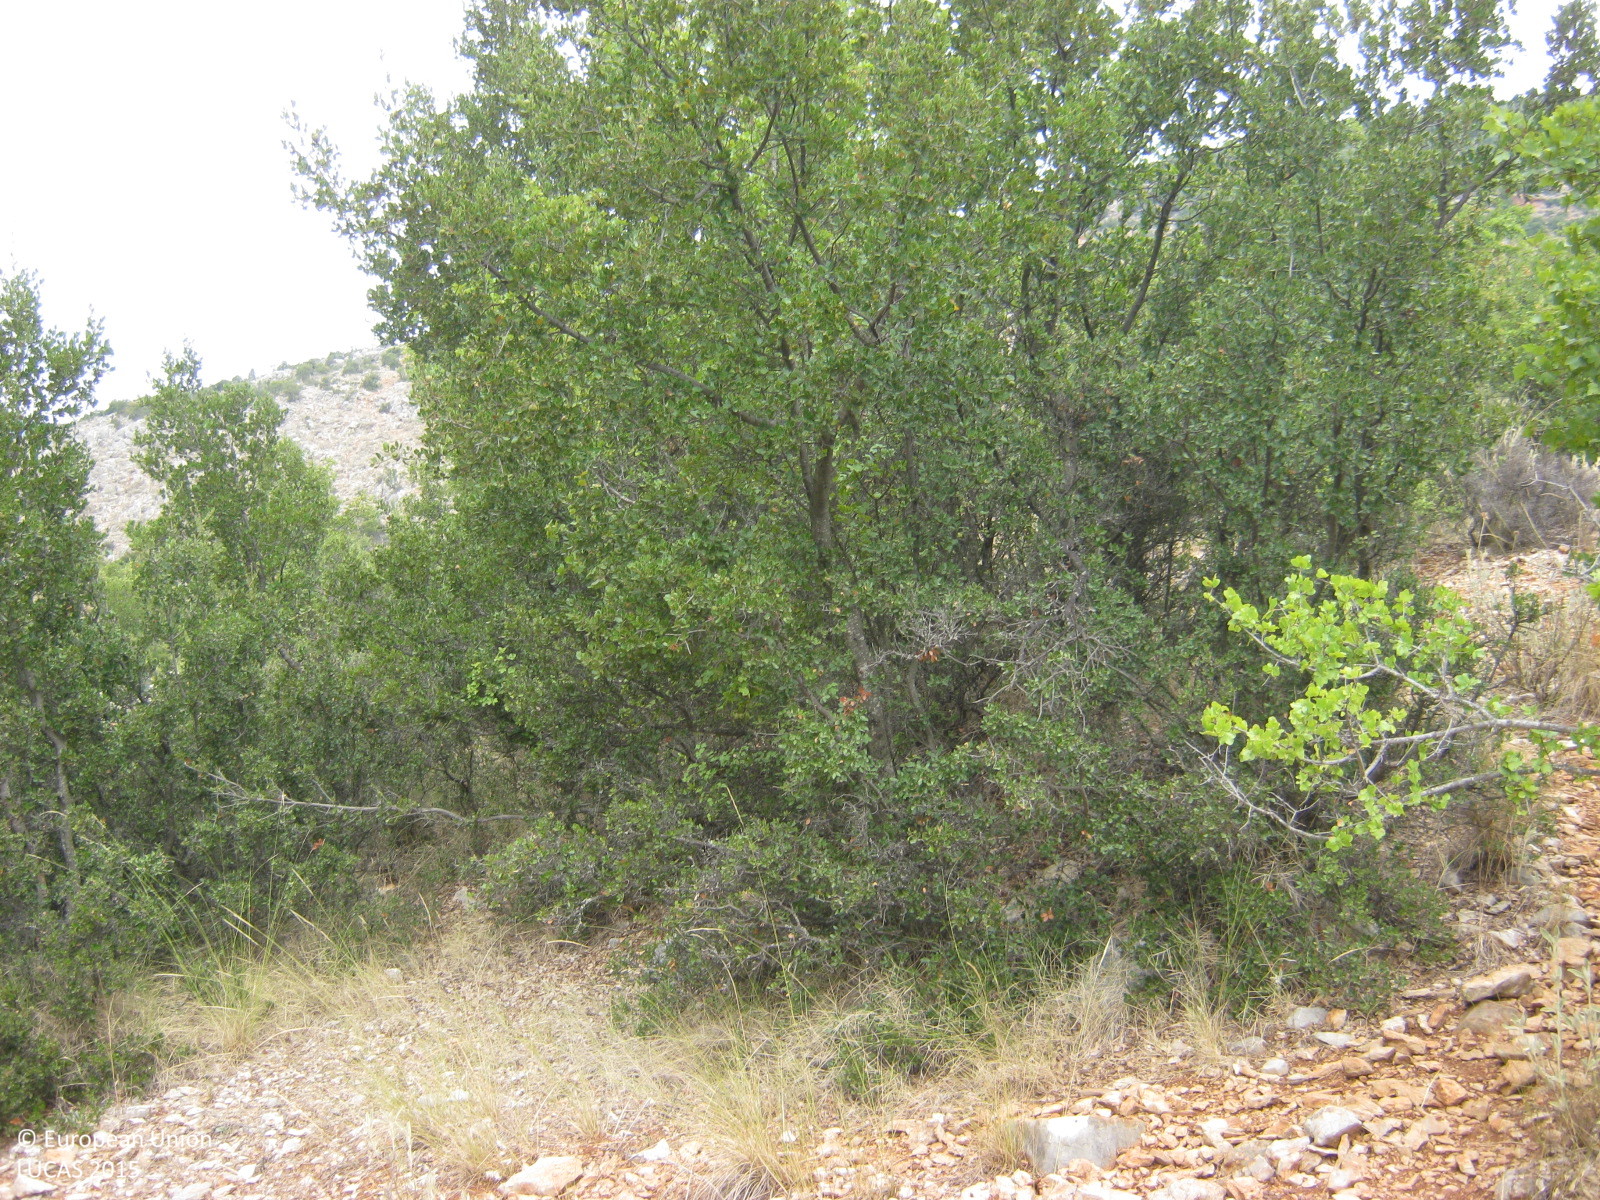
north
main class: Shrubland
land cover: Shrubland with sparse tree cover
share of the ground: 50 - 75 %
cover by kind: shrubs 50 %, unconsolidated bare surface 45 %, broadleaved forest trees 5 %
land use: Semi-natural and natural areas not in use
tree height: < 5 m
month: September
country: GR
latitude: 37.2782
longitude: 22.6939
